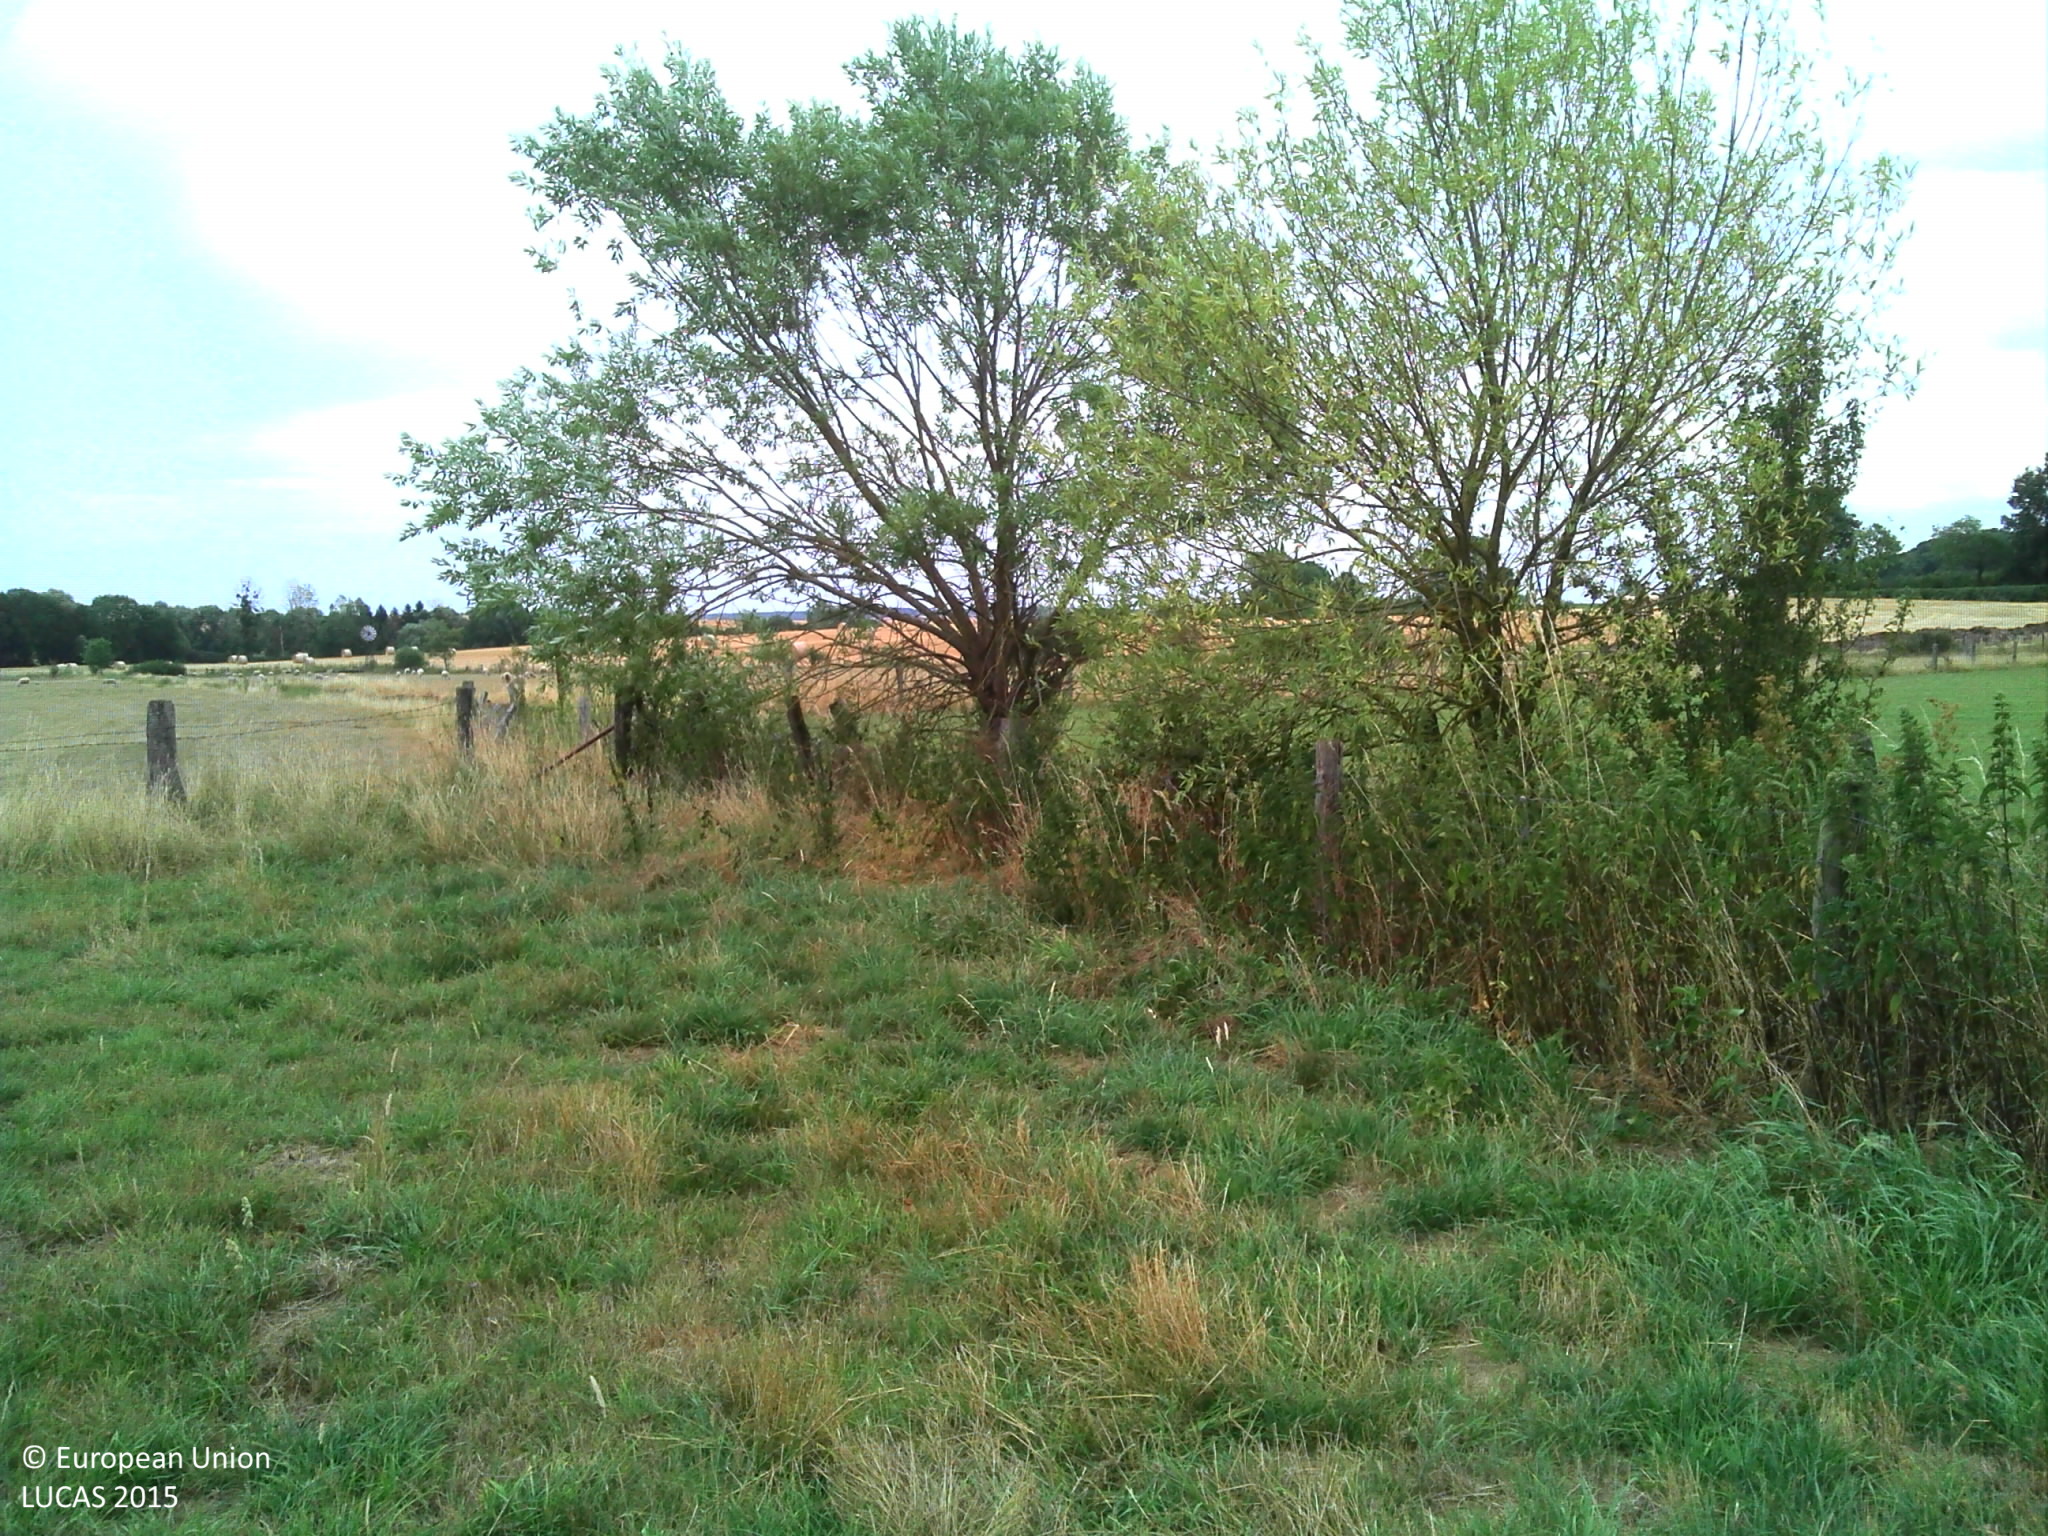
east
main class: Grassland
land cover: Grassland without tree/shrub cover
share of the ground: > 75 %
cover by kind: herbaceous plants 100 %
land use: Agriculture (excluding fallow land and kitchen gardens)
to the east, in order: Grassland without tree/shrub cover; Fences; Rivers and streams; Abandoned hedges; Fences; Grassland without tree/shrub cover; Fences; Grassland without tree/shrub cover; Fences; Shruby margins; Common wheat
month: July
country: FR
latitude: 48.3688
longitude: 6.0450
